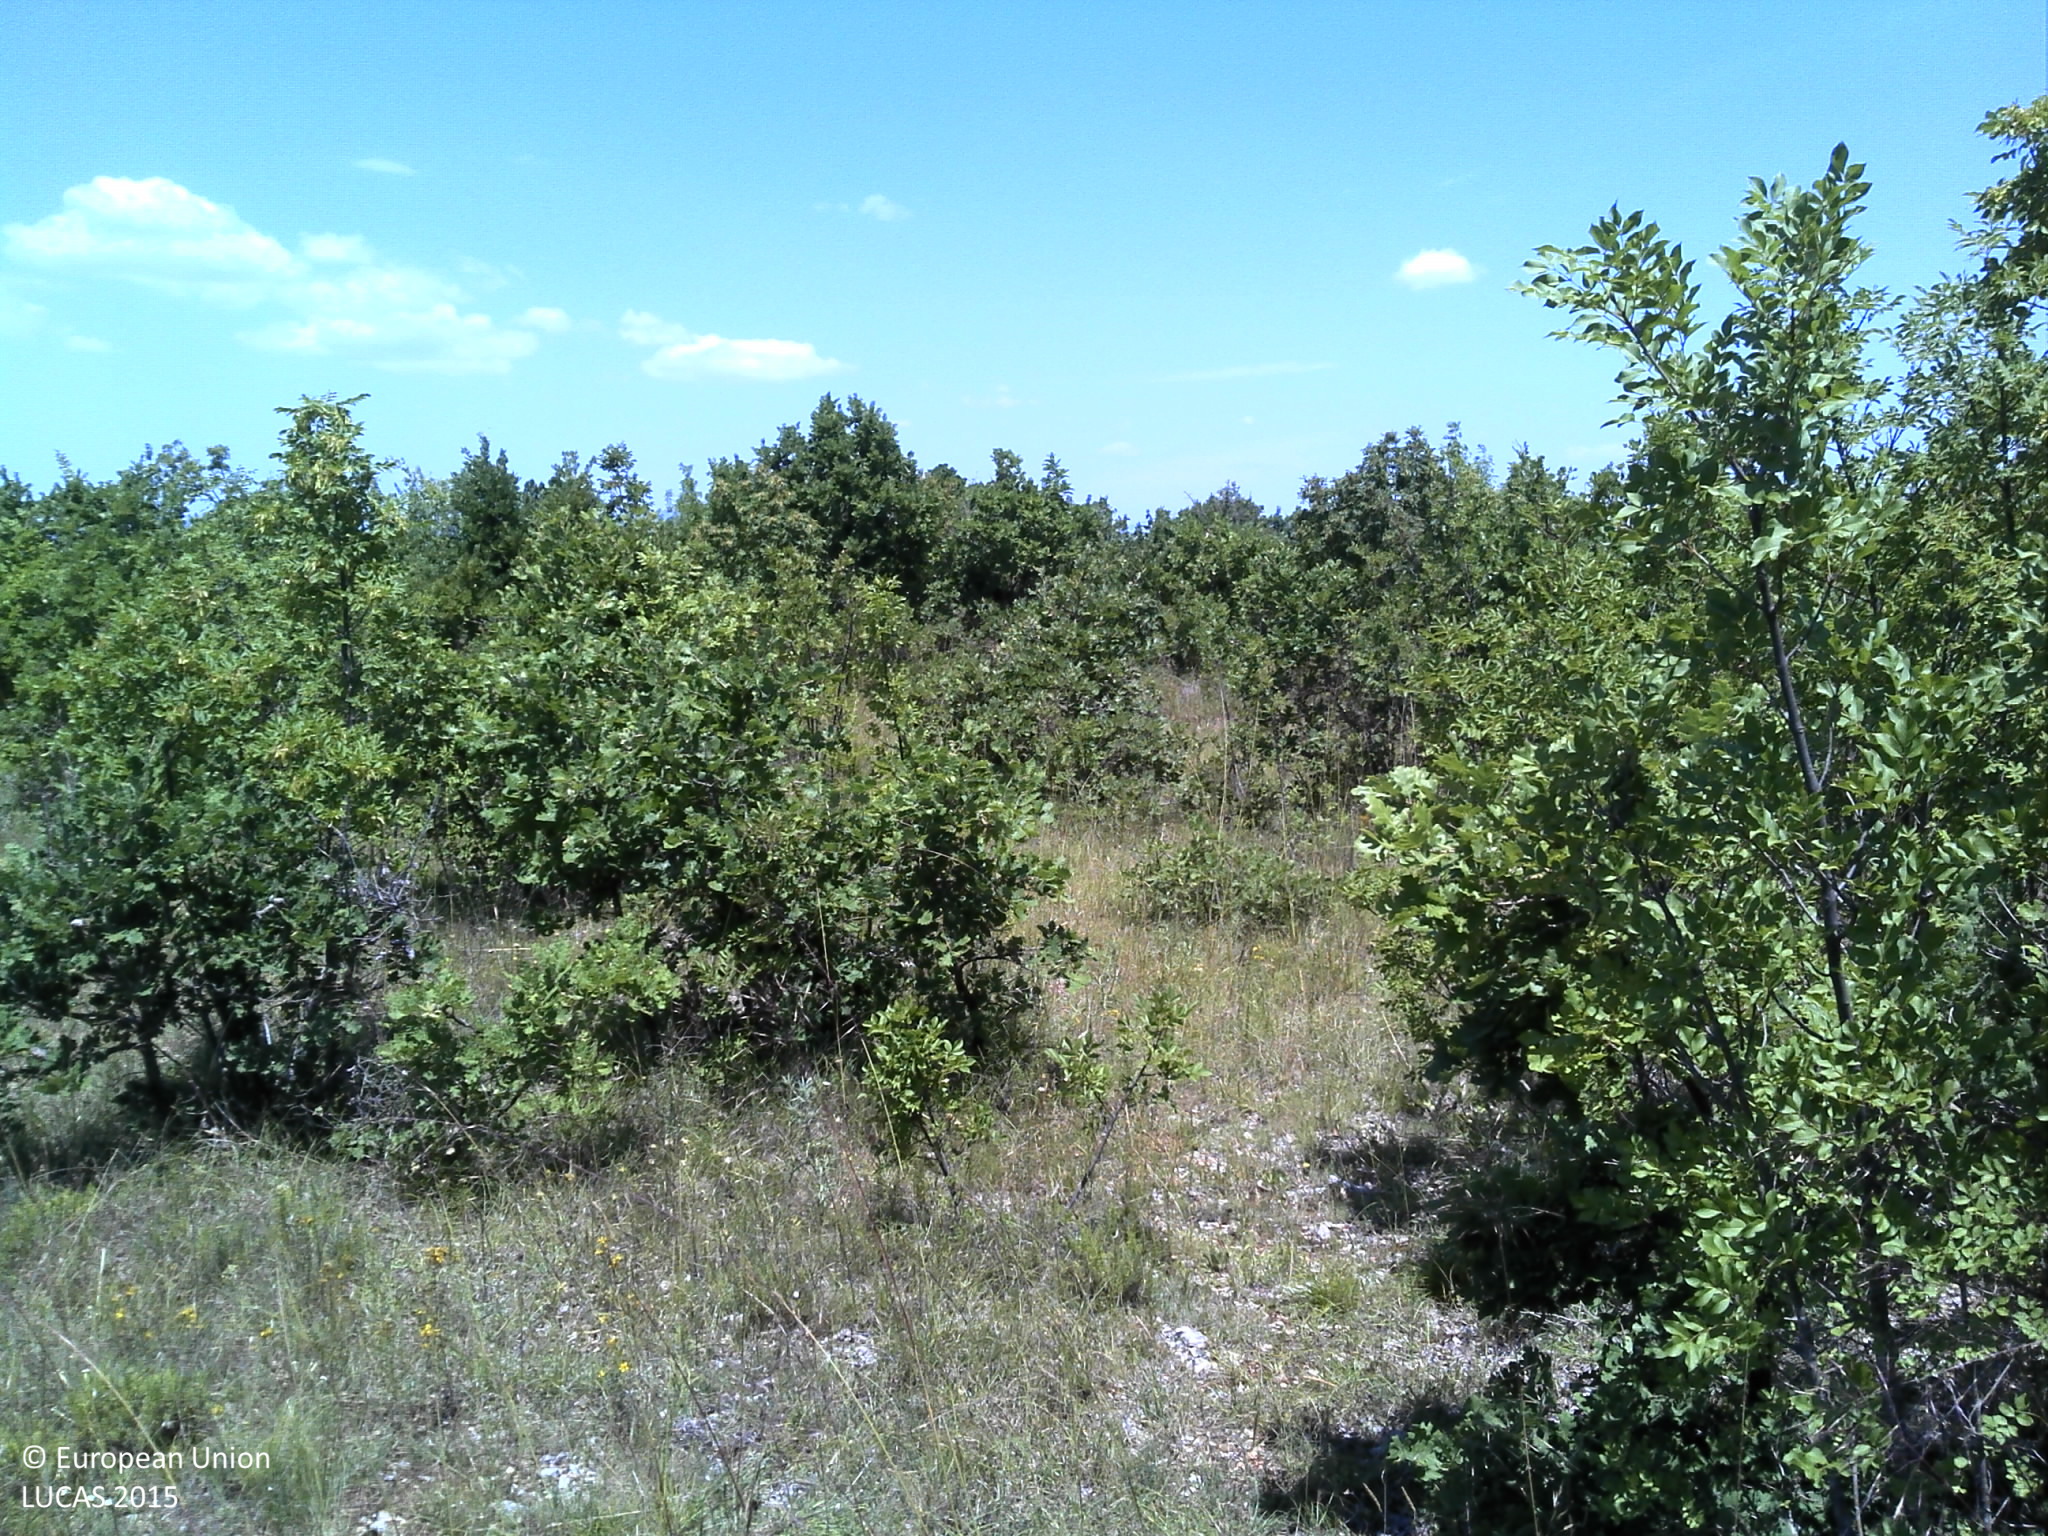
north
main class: Shrubland
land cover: Shrubland with sparse tree cover
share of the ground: 25 - 50 %
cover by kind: shrubs 45 %, herbaceous plants 40 %, broadleaved forest trees 5 %, consolidated bare surface 5 %, unconsolidated bare surface 5 %
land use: Semi-natural and natural areas not in use
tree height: < 5 m
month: July
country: HR
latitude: 43.9053
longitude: 16.0057
